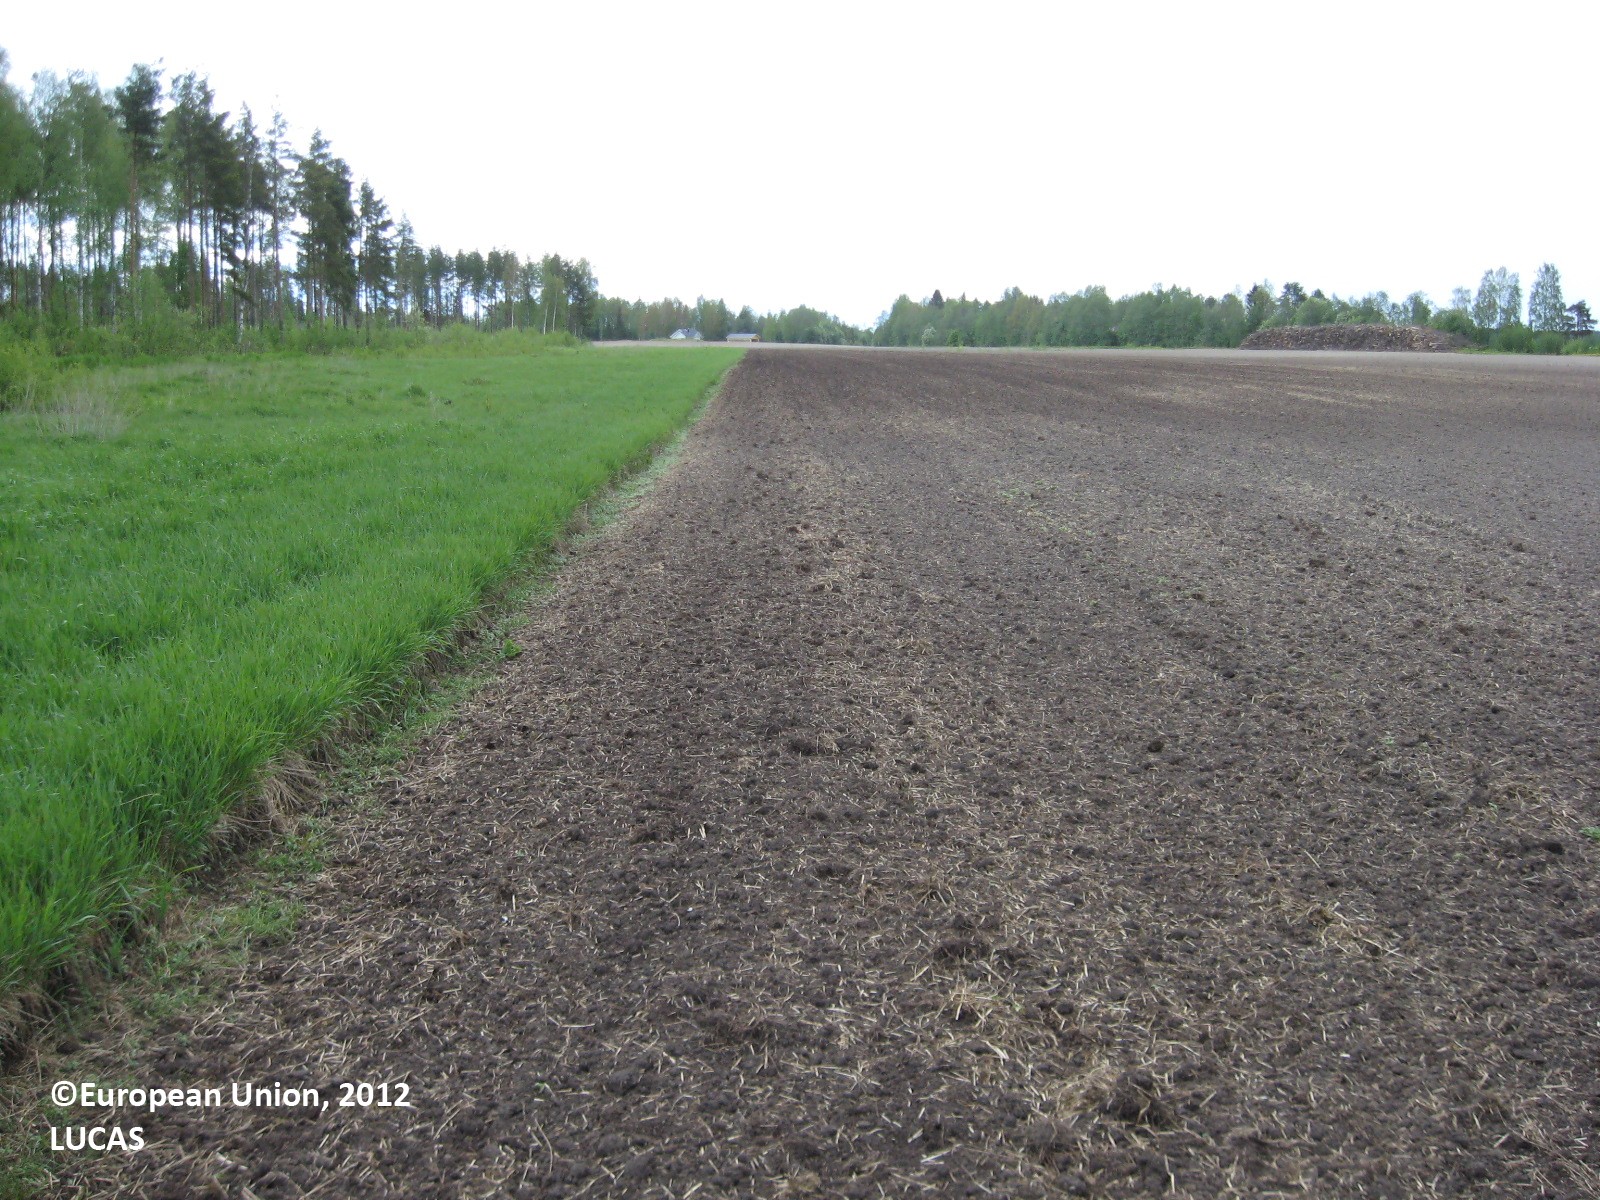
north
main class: Cropland
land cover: Other cereals
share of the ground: < 10 %
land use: Agriculture (excluding fallow land and kitchen gardens)
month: May
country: FI
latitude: 61.8311
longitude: 22.3060
